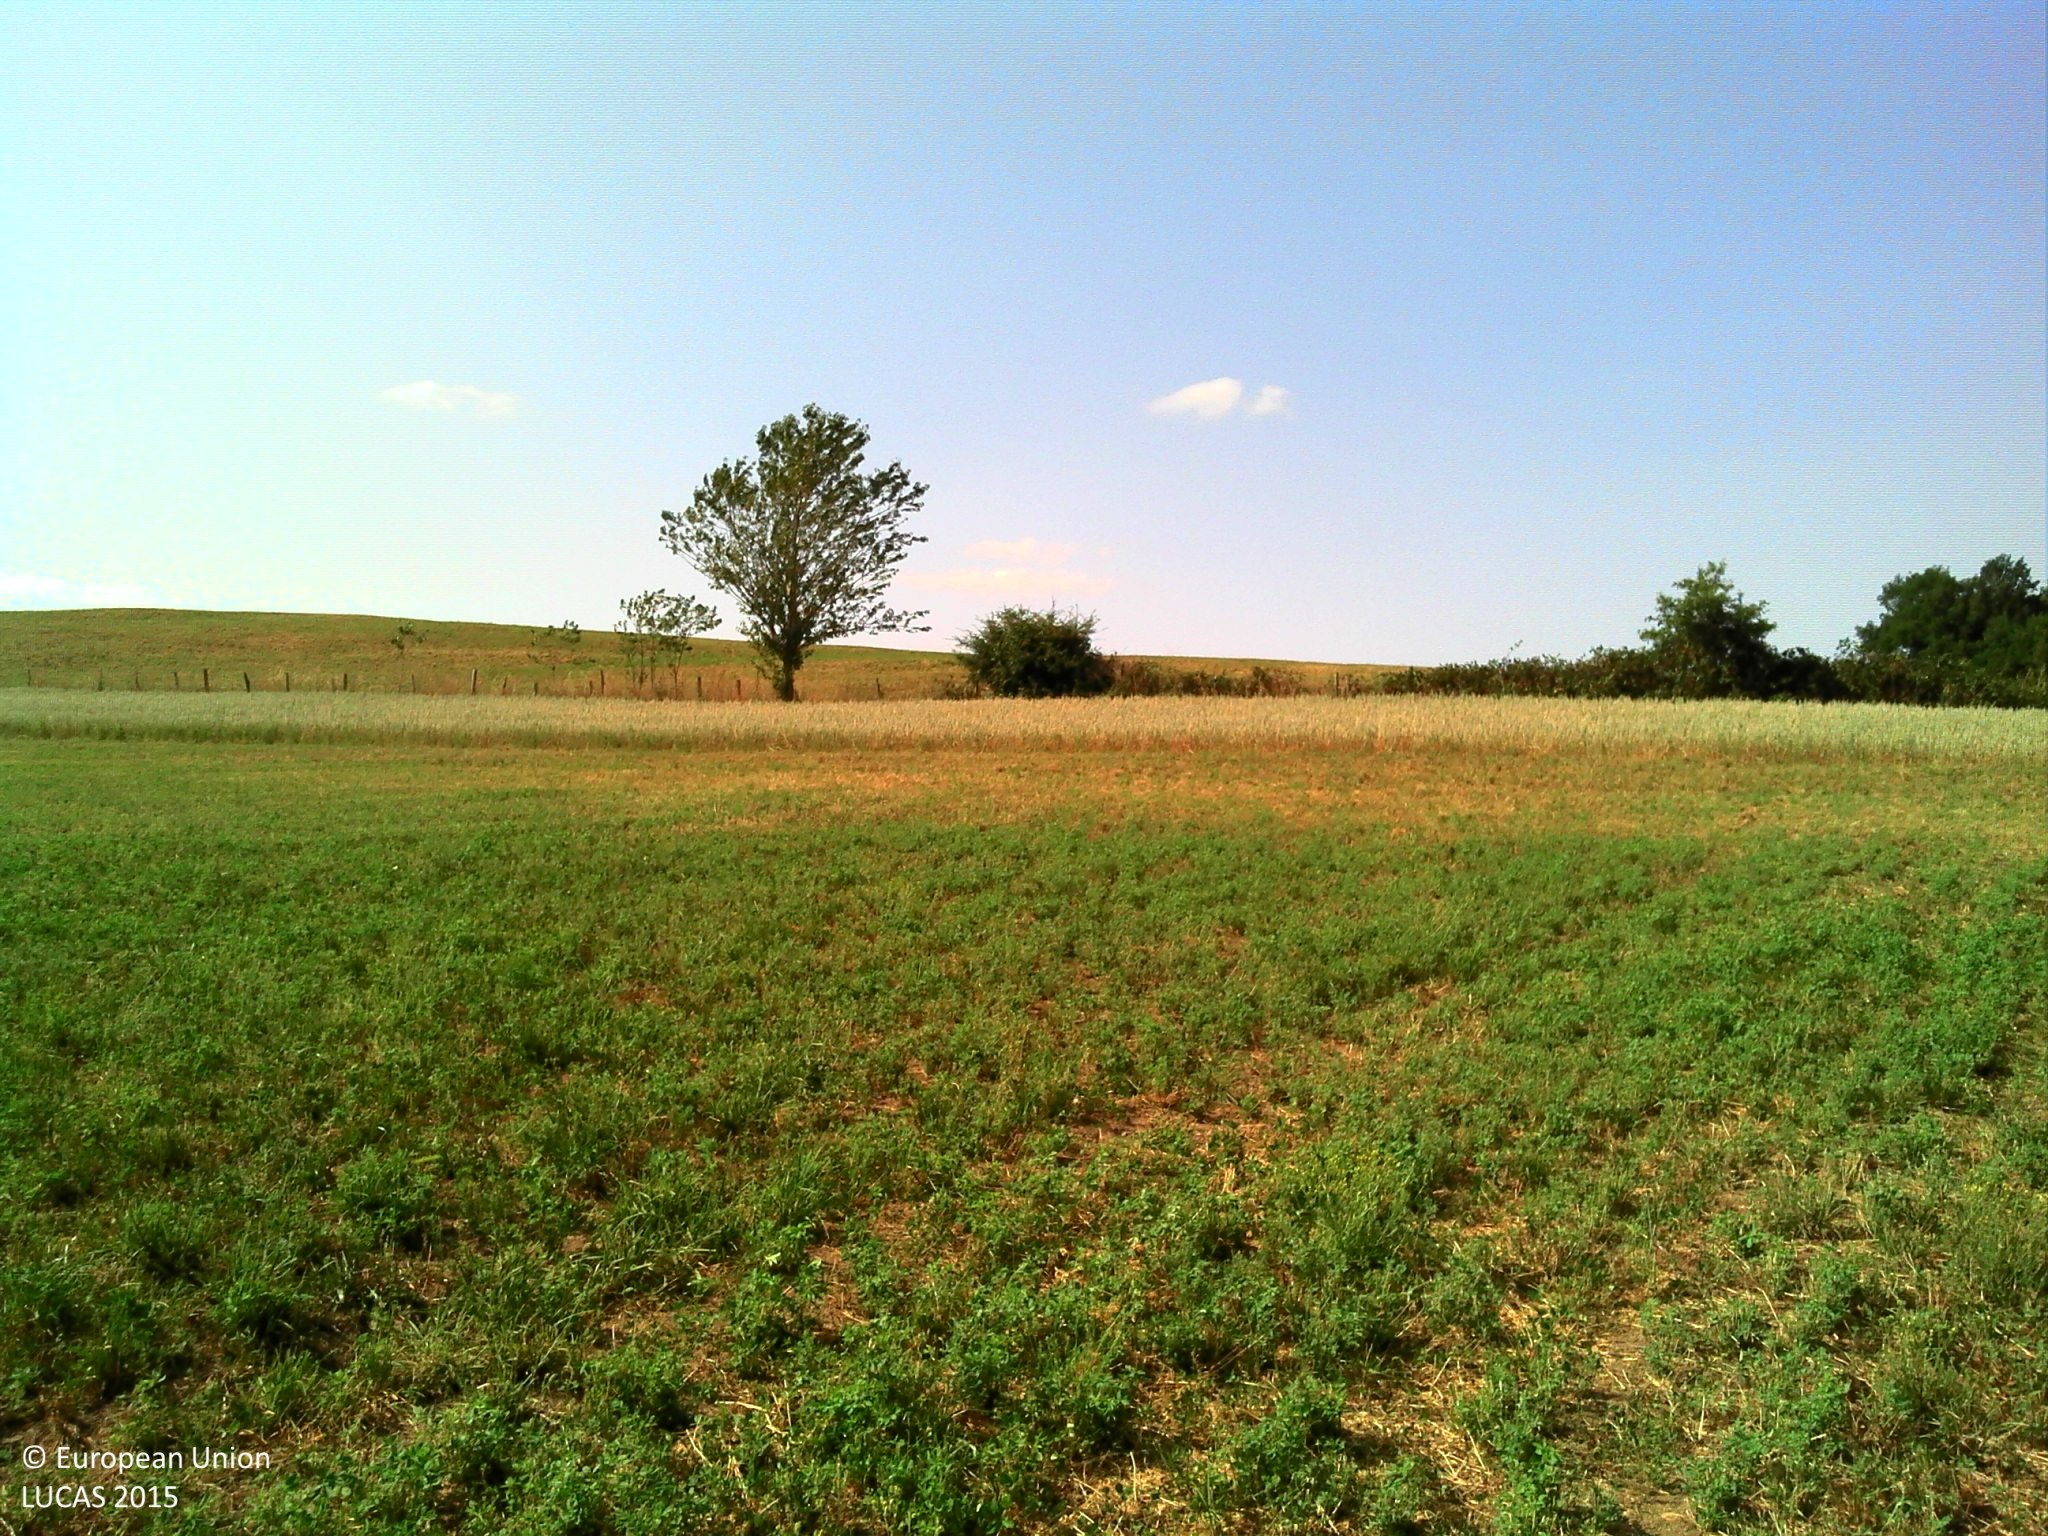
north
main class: Cropland
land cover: Lucerne
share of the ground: > 75 %
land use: Agriculture (excluding fallow land and kitchen gardens)
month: July
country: FR
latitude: 44.1399
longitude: 2.5917
